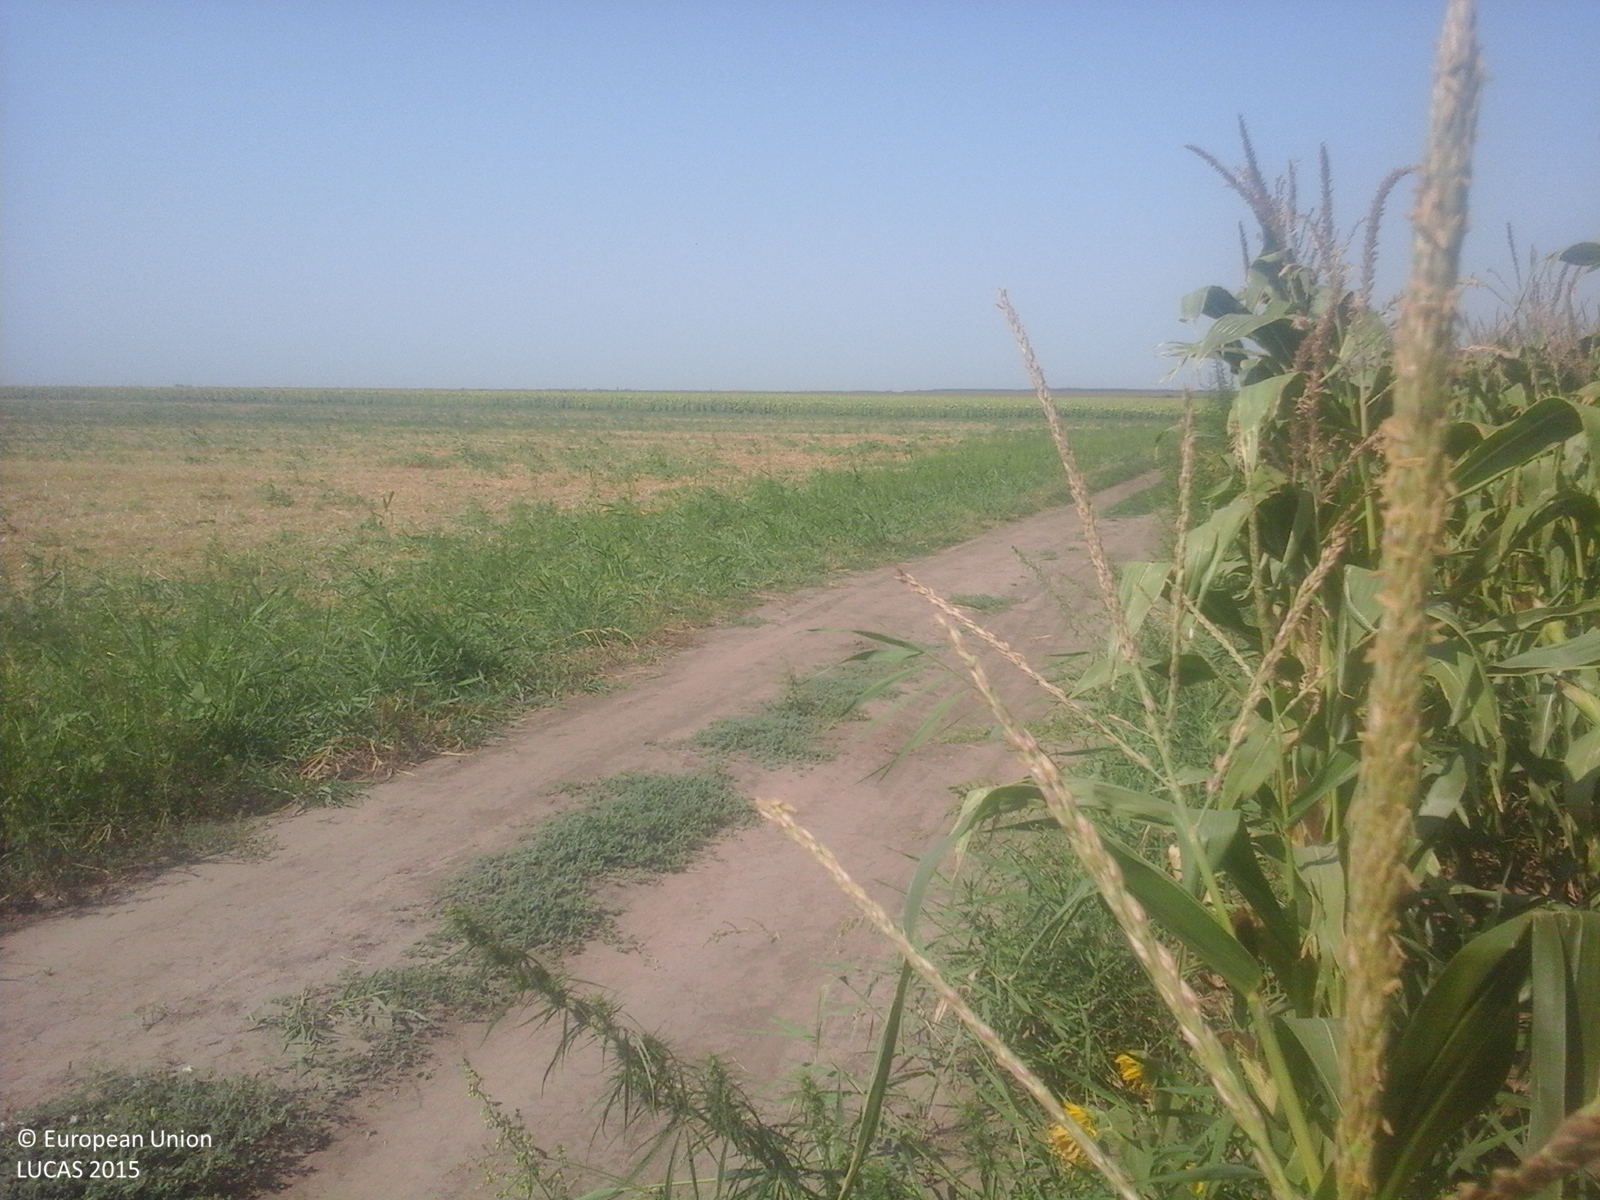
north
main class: Cropland
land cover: Maize
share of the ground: > 75 %
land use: Agriculture (excluding fallow land and kitchen gardens)
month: August
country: RO
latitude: 45.2196
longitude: 27.5344
